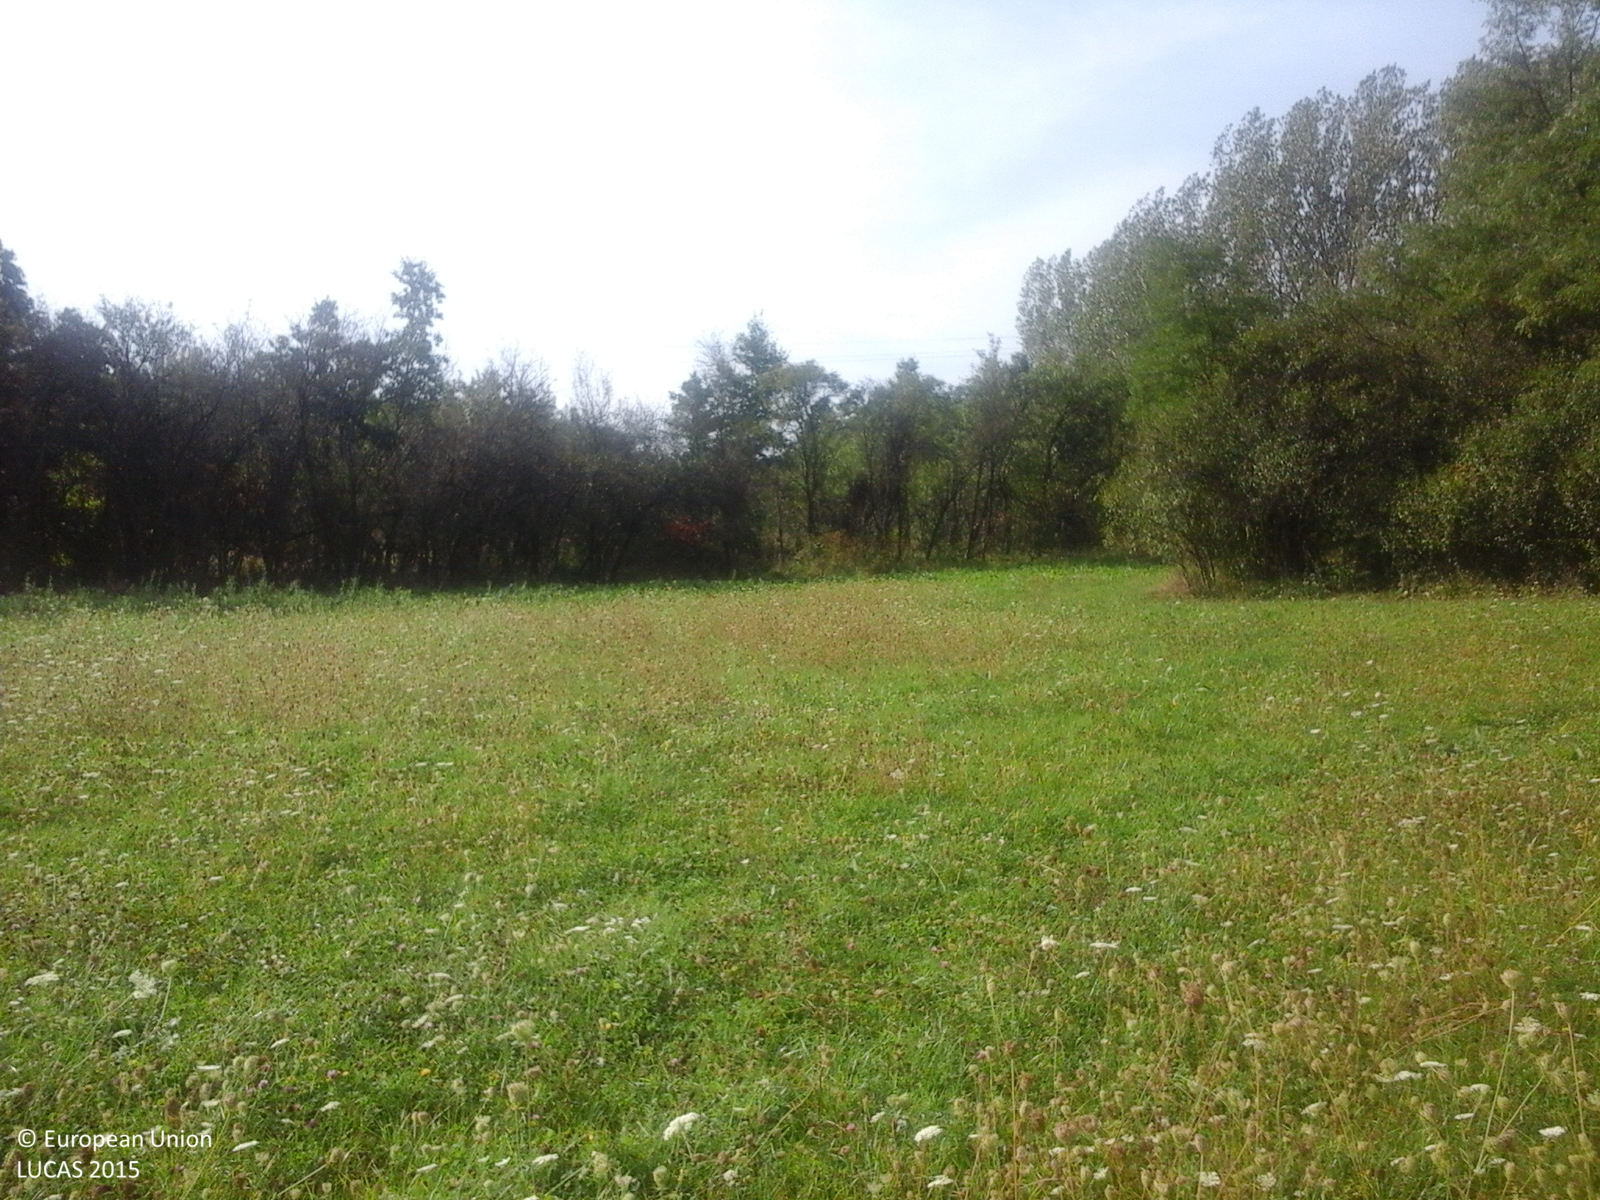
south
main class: Grassland
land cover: Grassland without tree/shrub cover
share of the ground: > 75 %
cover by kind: herbaceous plants 100 %
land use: Agriculture (excluding fallow land and kitchen gardens)
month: September
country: RO
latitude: 46.9509
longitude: 23.3516
